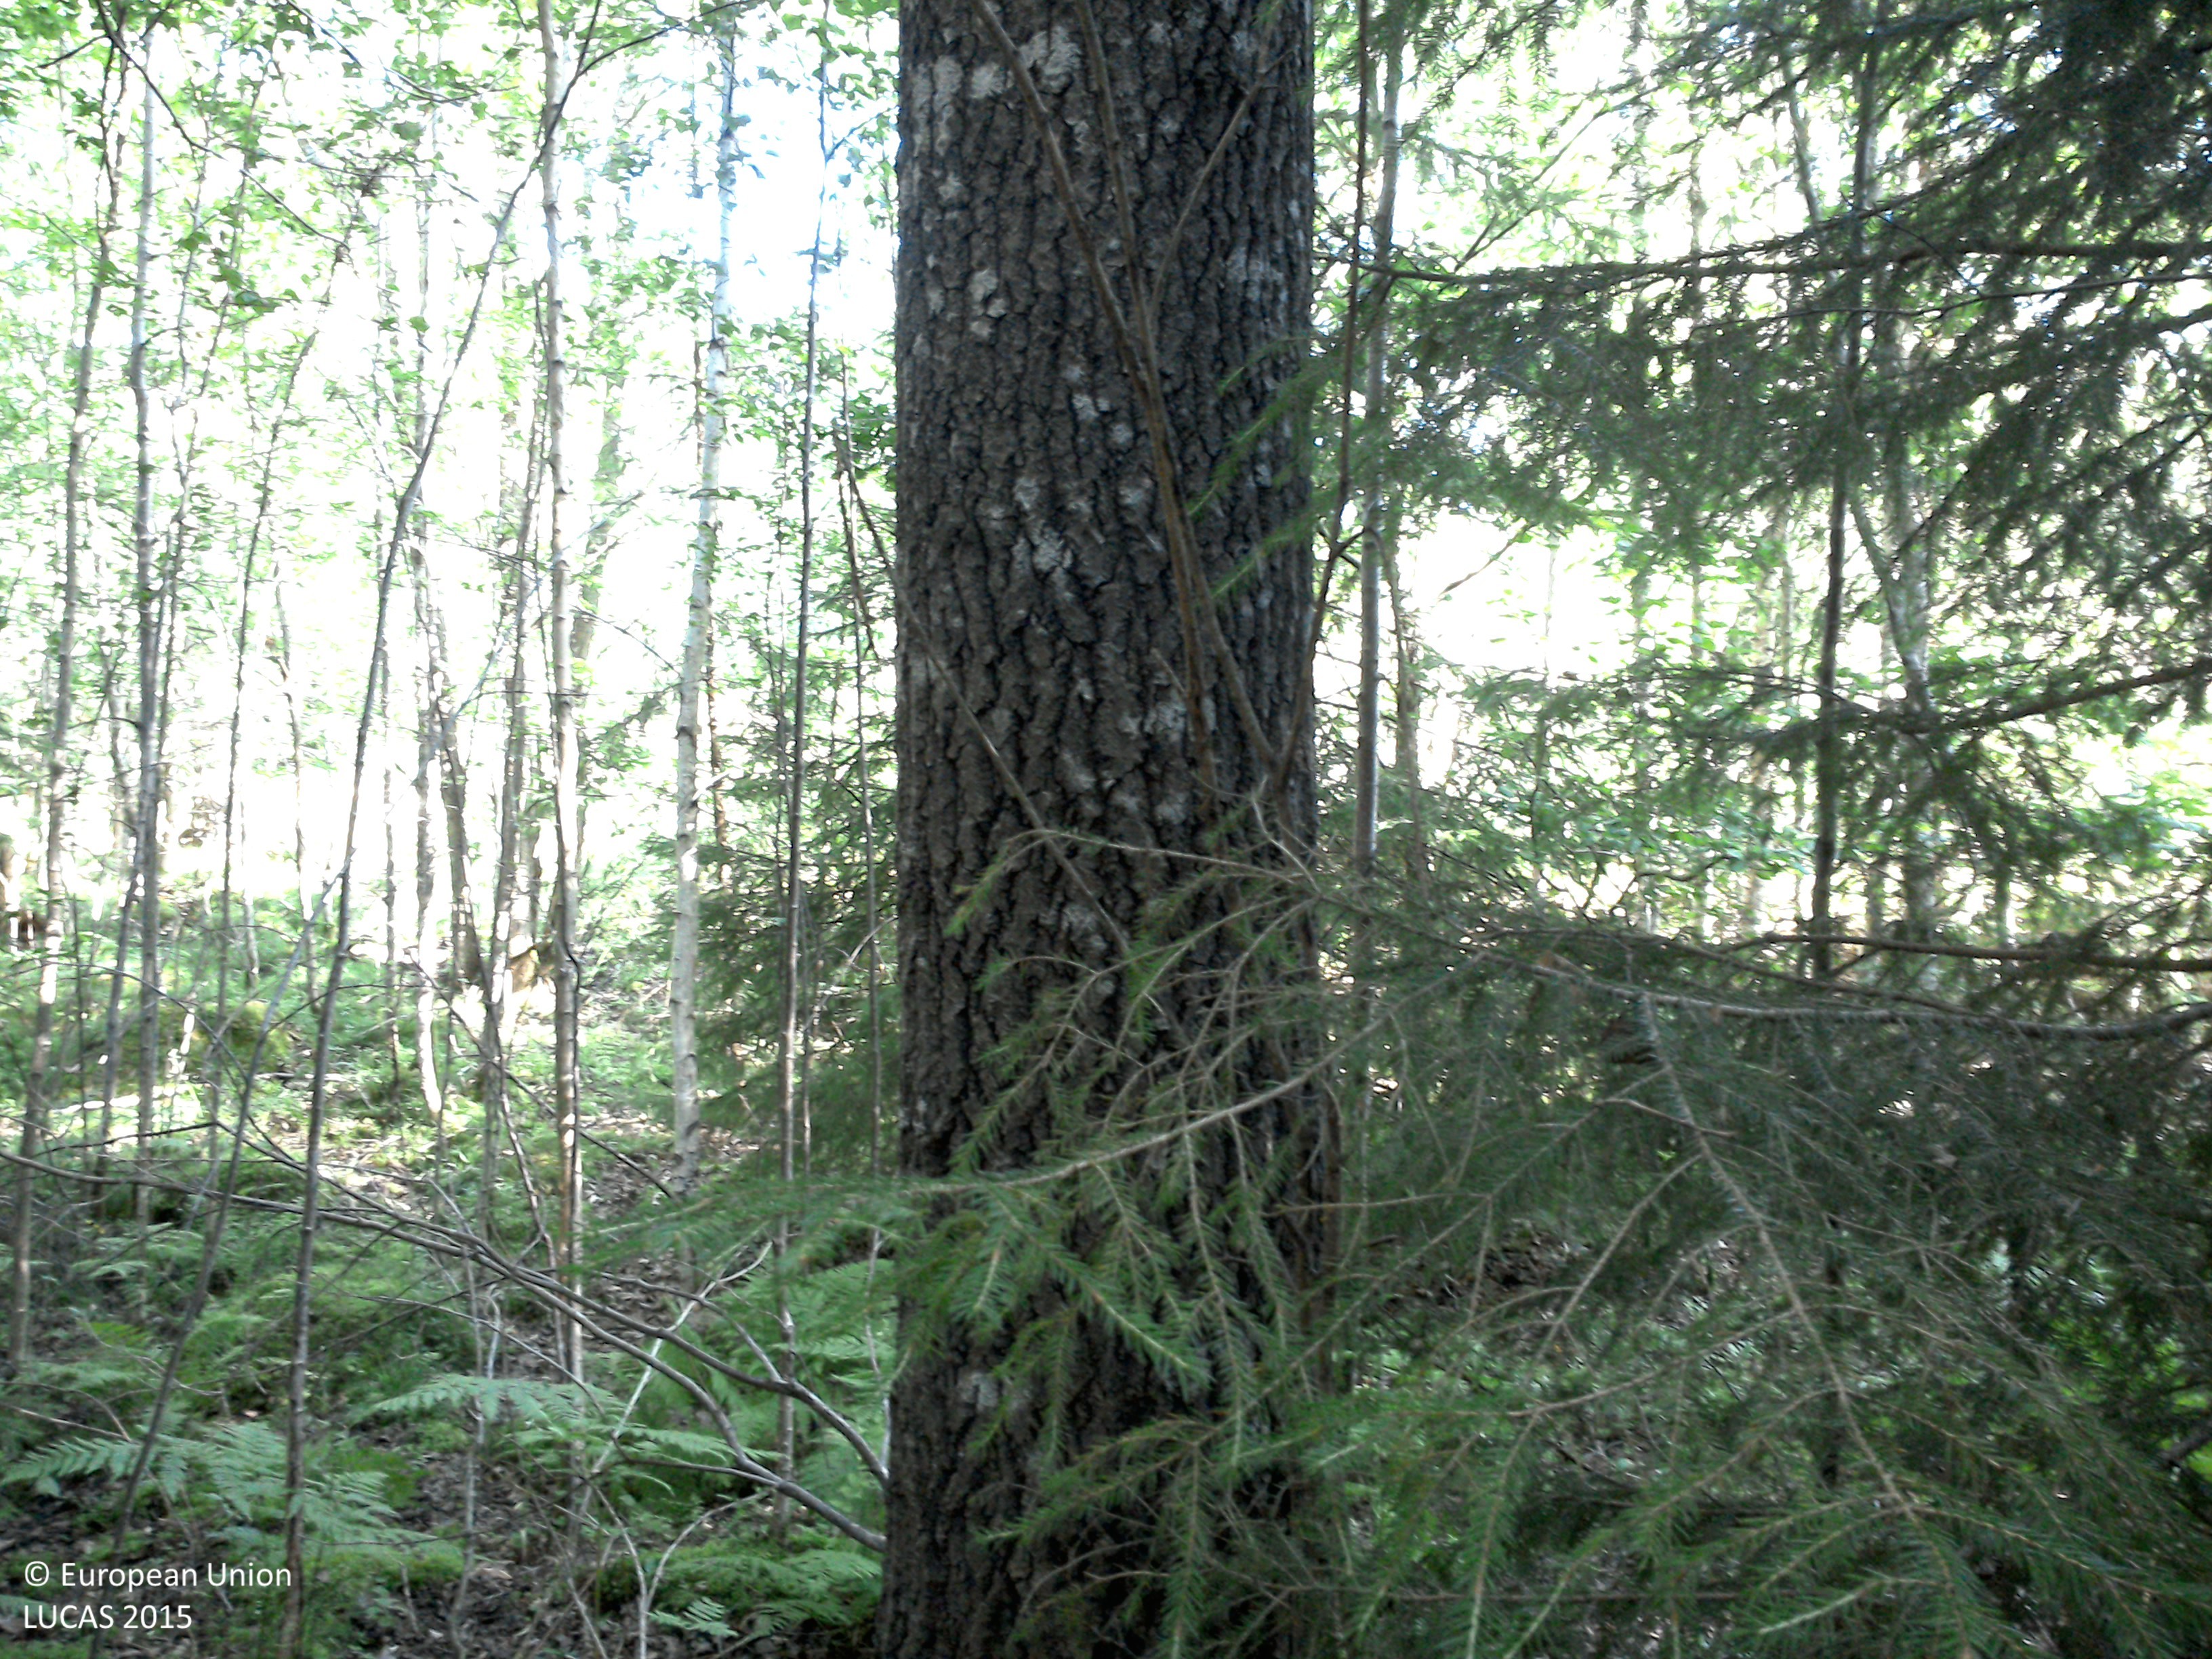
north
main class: Woodland
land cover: Pine dominated mixed woodland
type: boreal forest
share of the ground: > 75 %
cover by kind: coniferous forest trees 50 %, broadleaved forest trees 25 %, herbaceous plants 15 %, unconsolidated bare surface 10 %
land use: Forestry
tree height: > 5 m
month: July
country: SE
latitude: 58.2595
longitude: 15.2949
